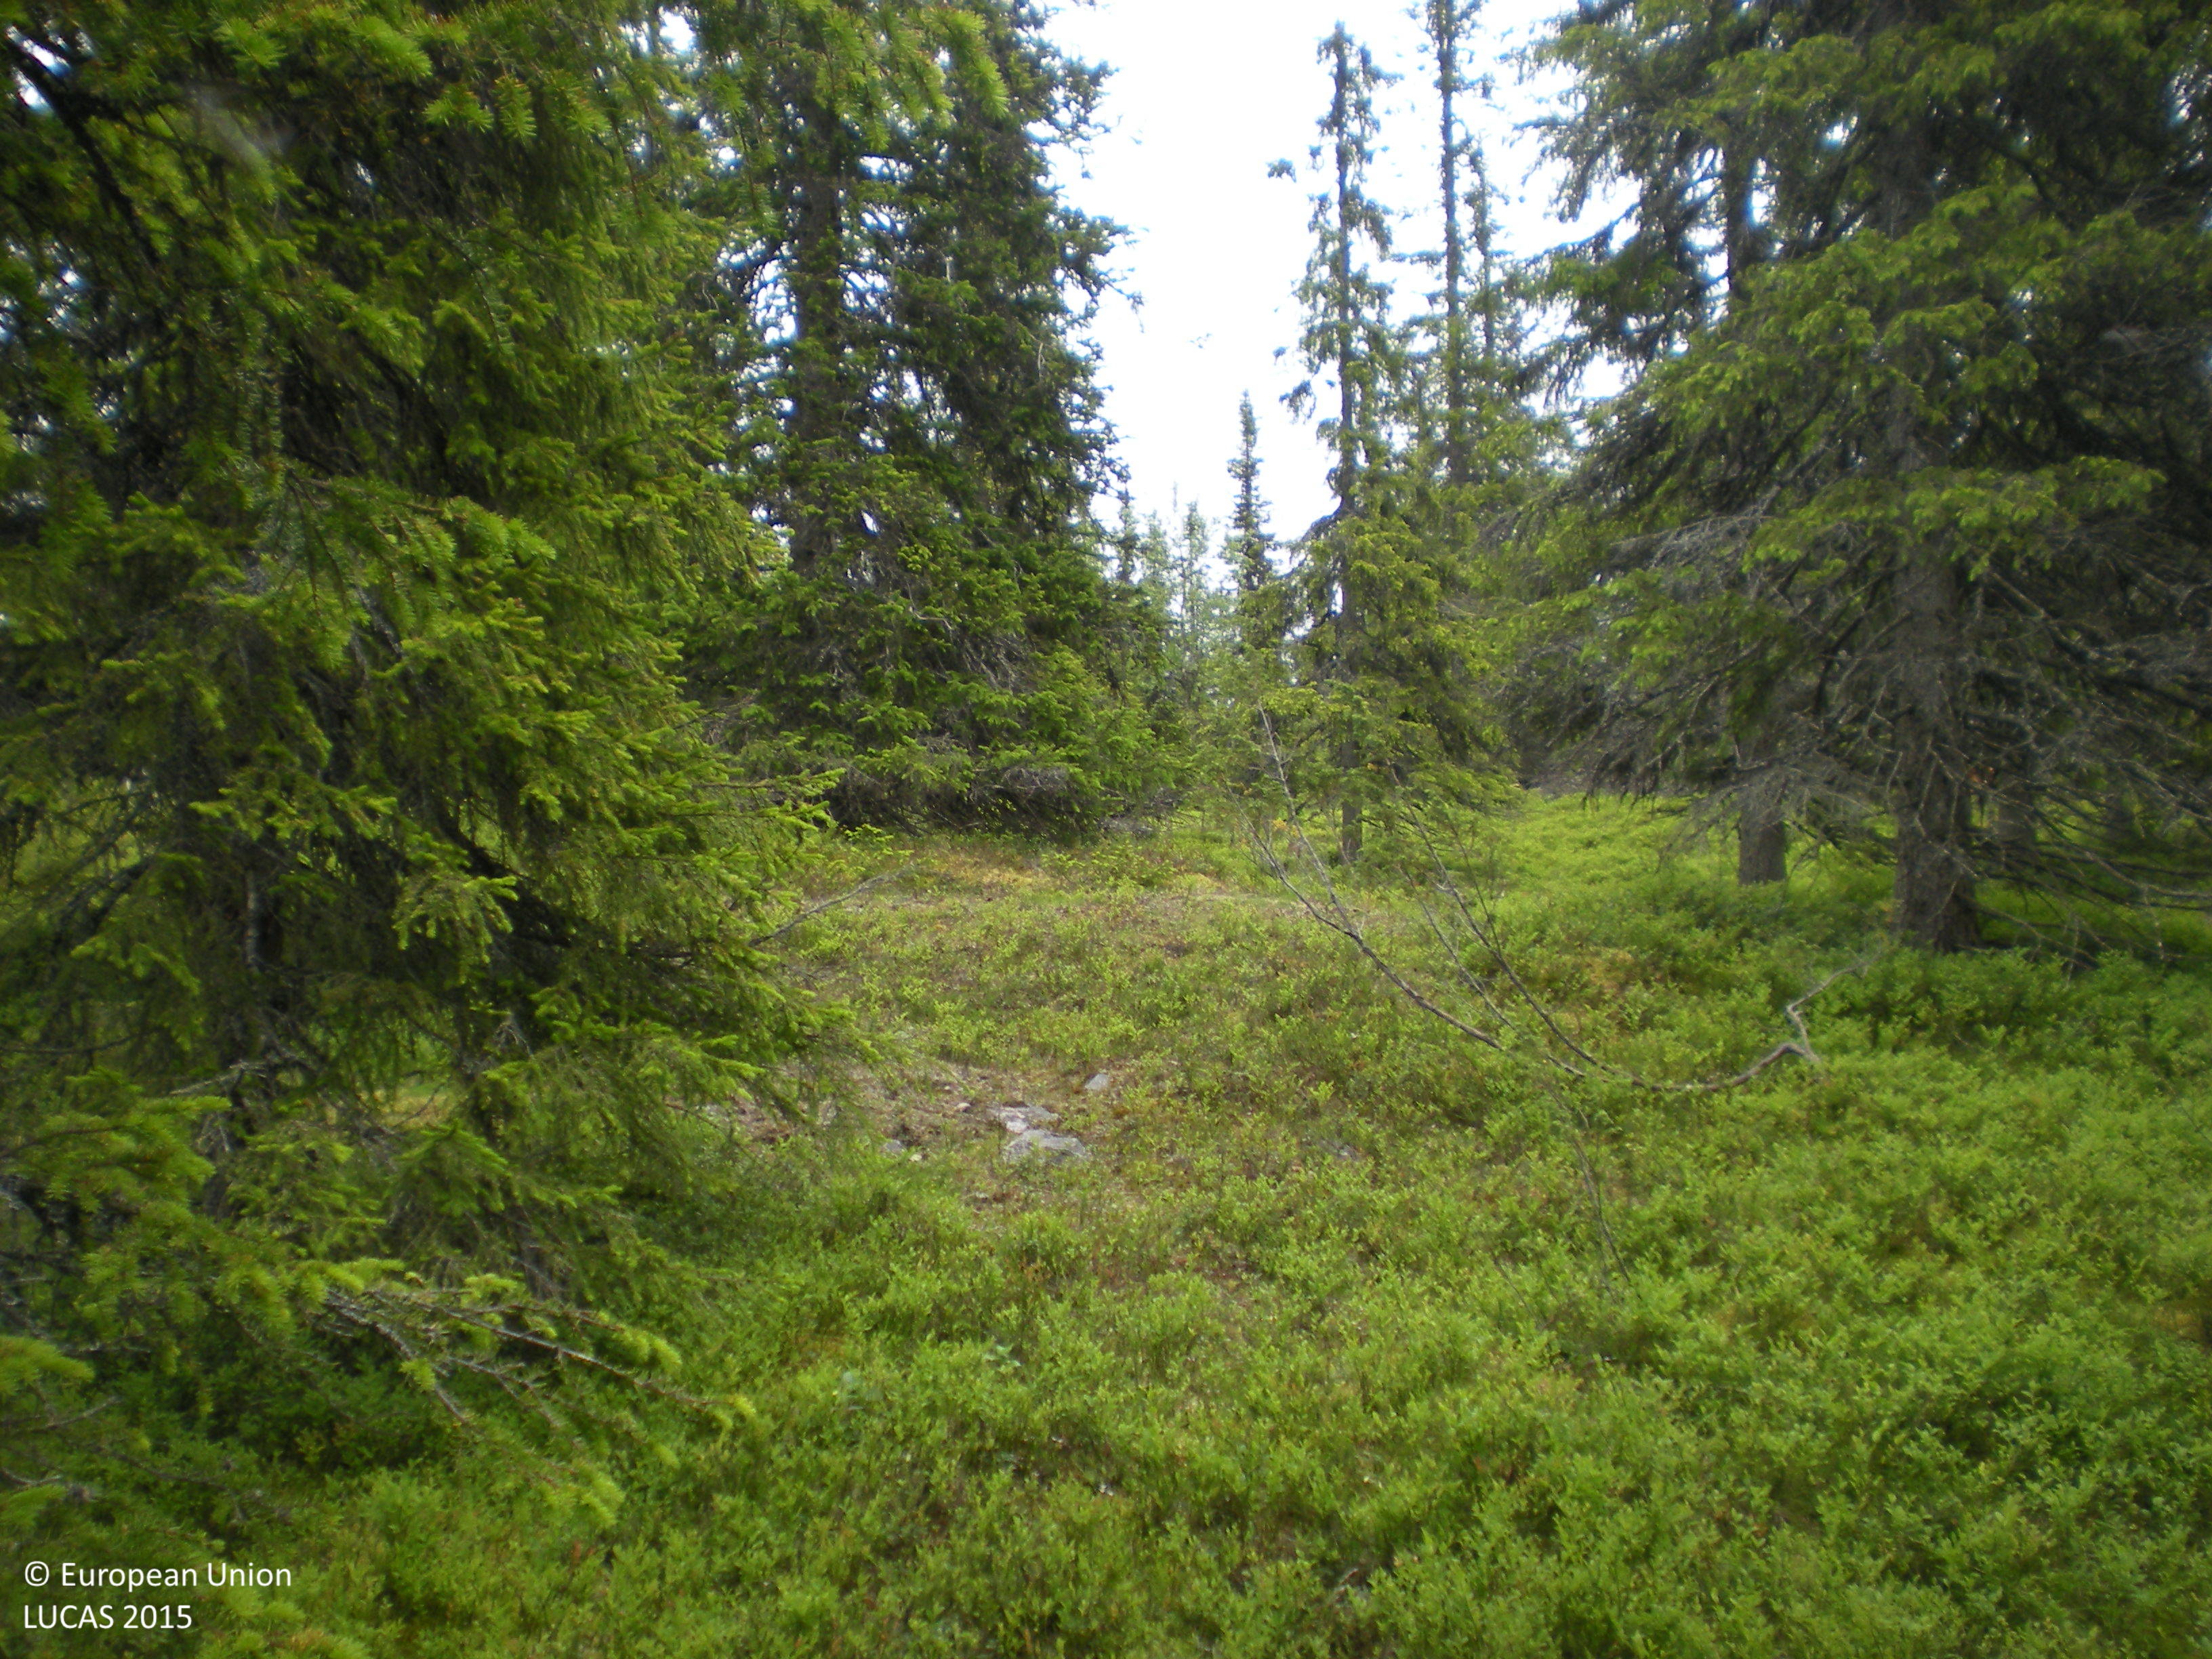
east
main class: Woodland
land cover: Spruce dominated mixed woodland
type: boreal forest
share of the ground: 50 - 75 %
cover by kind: coniferous forest trees 50 %, broadleaved forest trees 20 %, shrubs 20 %, herbaceous plants 5 %, lichens and mosses 5 %
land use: Forestry
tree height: > 5 m
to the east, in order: Spruce dominated mixed woodland; Spruce dominated coniferous woodland
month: July
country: SE
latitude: 65.9297
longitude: 18.2399
